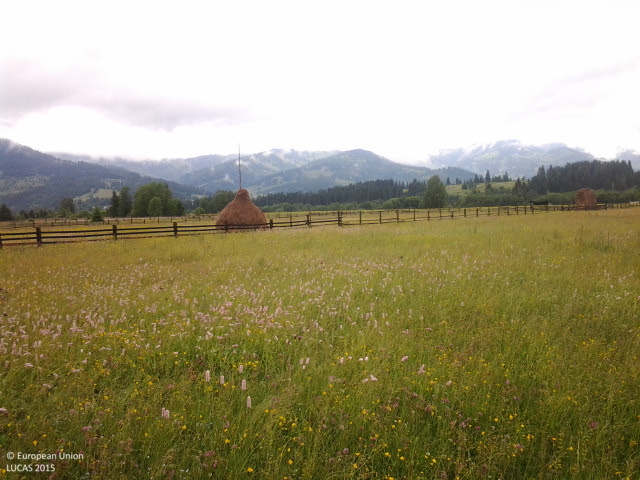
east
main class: Grassland
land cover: Grassland without tree/shrub cover
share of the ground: > 75 %
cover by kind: herbaceous plants 100 %
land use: Agriculture (excluding fallow land and kitchen gardens)
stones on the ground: < 10 %
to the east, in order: Grassland without tree/shrub cover; Electric lines; Grassland without tree/shrub cover; Fences; Grassland without tree/shrub cover; Fences; Grassland without tree/shrub cover; Fences; Grassland without tree/shrub cover
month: June
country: RO
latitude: 47.2507
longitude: 25.3452
